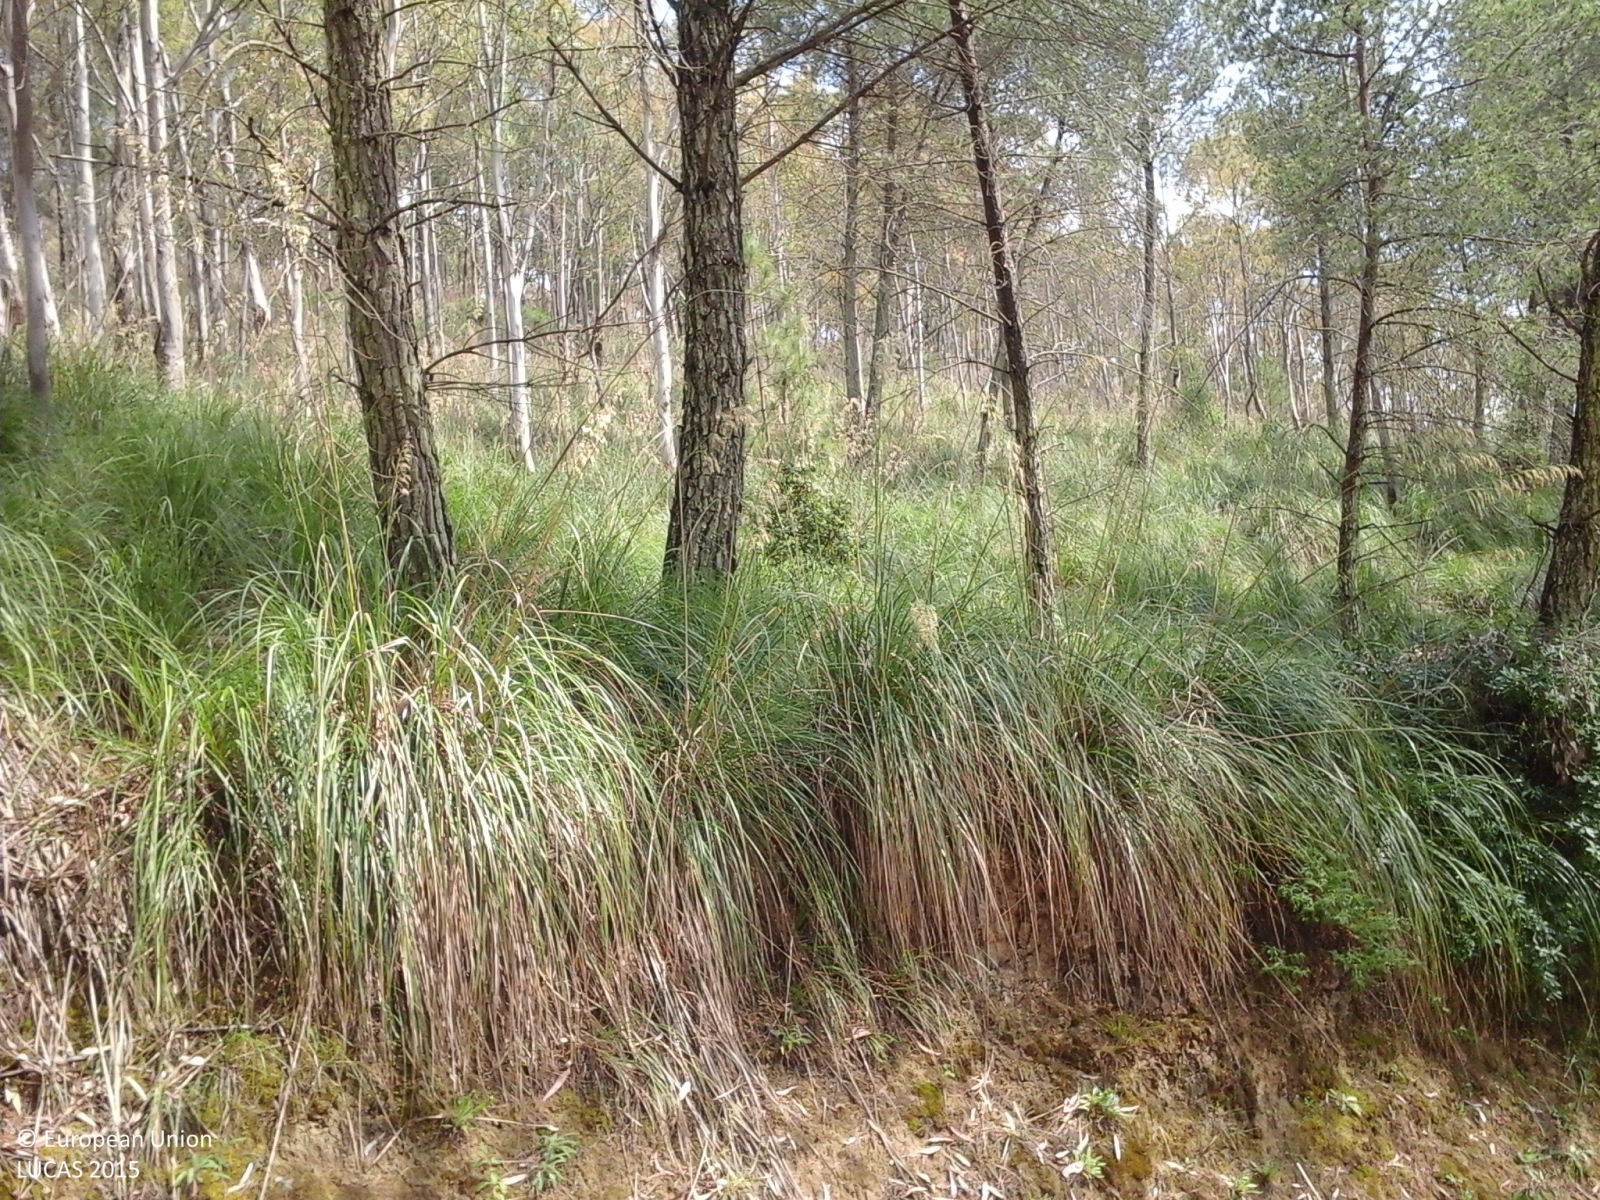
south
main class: Woodland
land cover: Broadleaved woodland
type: thermophilous deciduous forest
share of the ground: > 75 %
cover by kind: broadleaved forest trees 70 %, shrubs 20 %, herbaceous plants 10 %
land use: Forestry
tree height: > 5 m
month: June
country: IT
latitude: 37.2629
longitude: 14.4202
